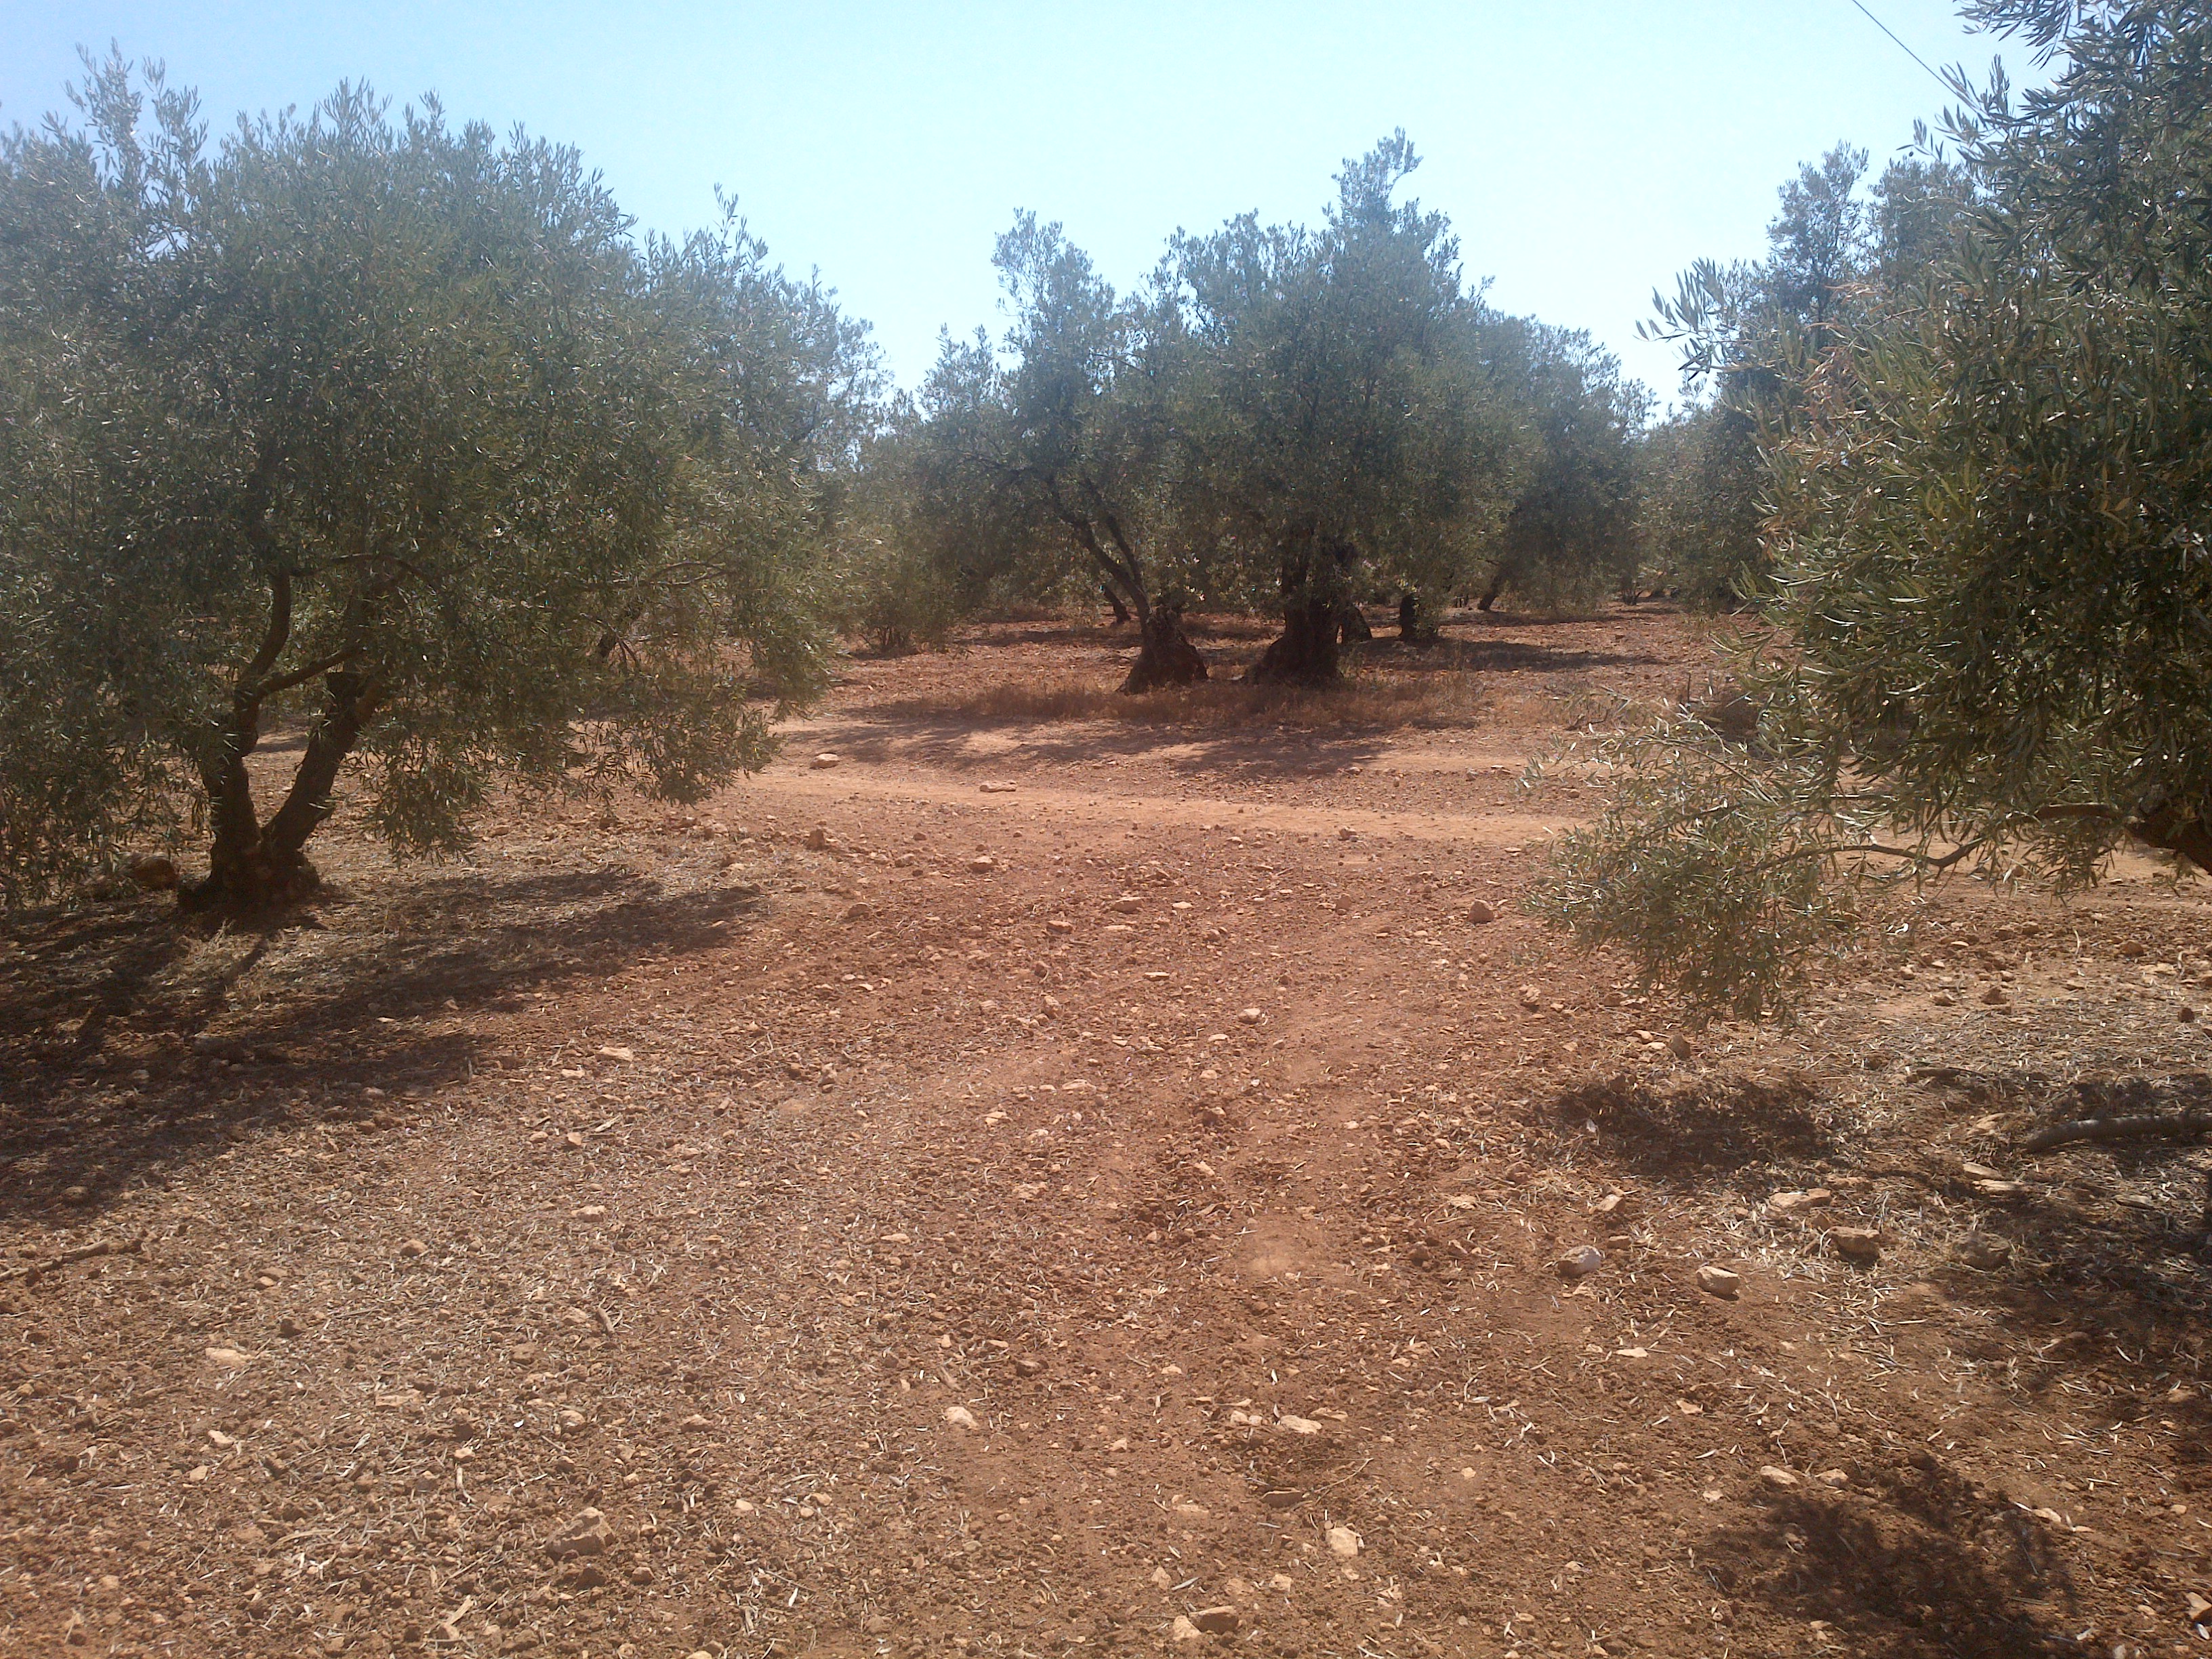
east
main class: Cropland
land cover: Olive groves
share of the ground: 50 - 75 %
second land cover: Other bare soil
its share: > 75 %
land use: Agriculture (excluding fallow land and kitchen gardens)
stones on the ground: 10 - 25 %
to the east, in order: Olive groves; Other bare soil; Electric lines; Olive groves; Tracks; Olive groves; Other structural elements; Olive groves
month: July
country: ES
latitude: 37.3898
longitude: -4.8141
